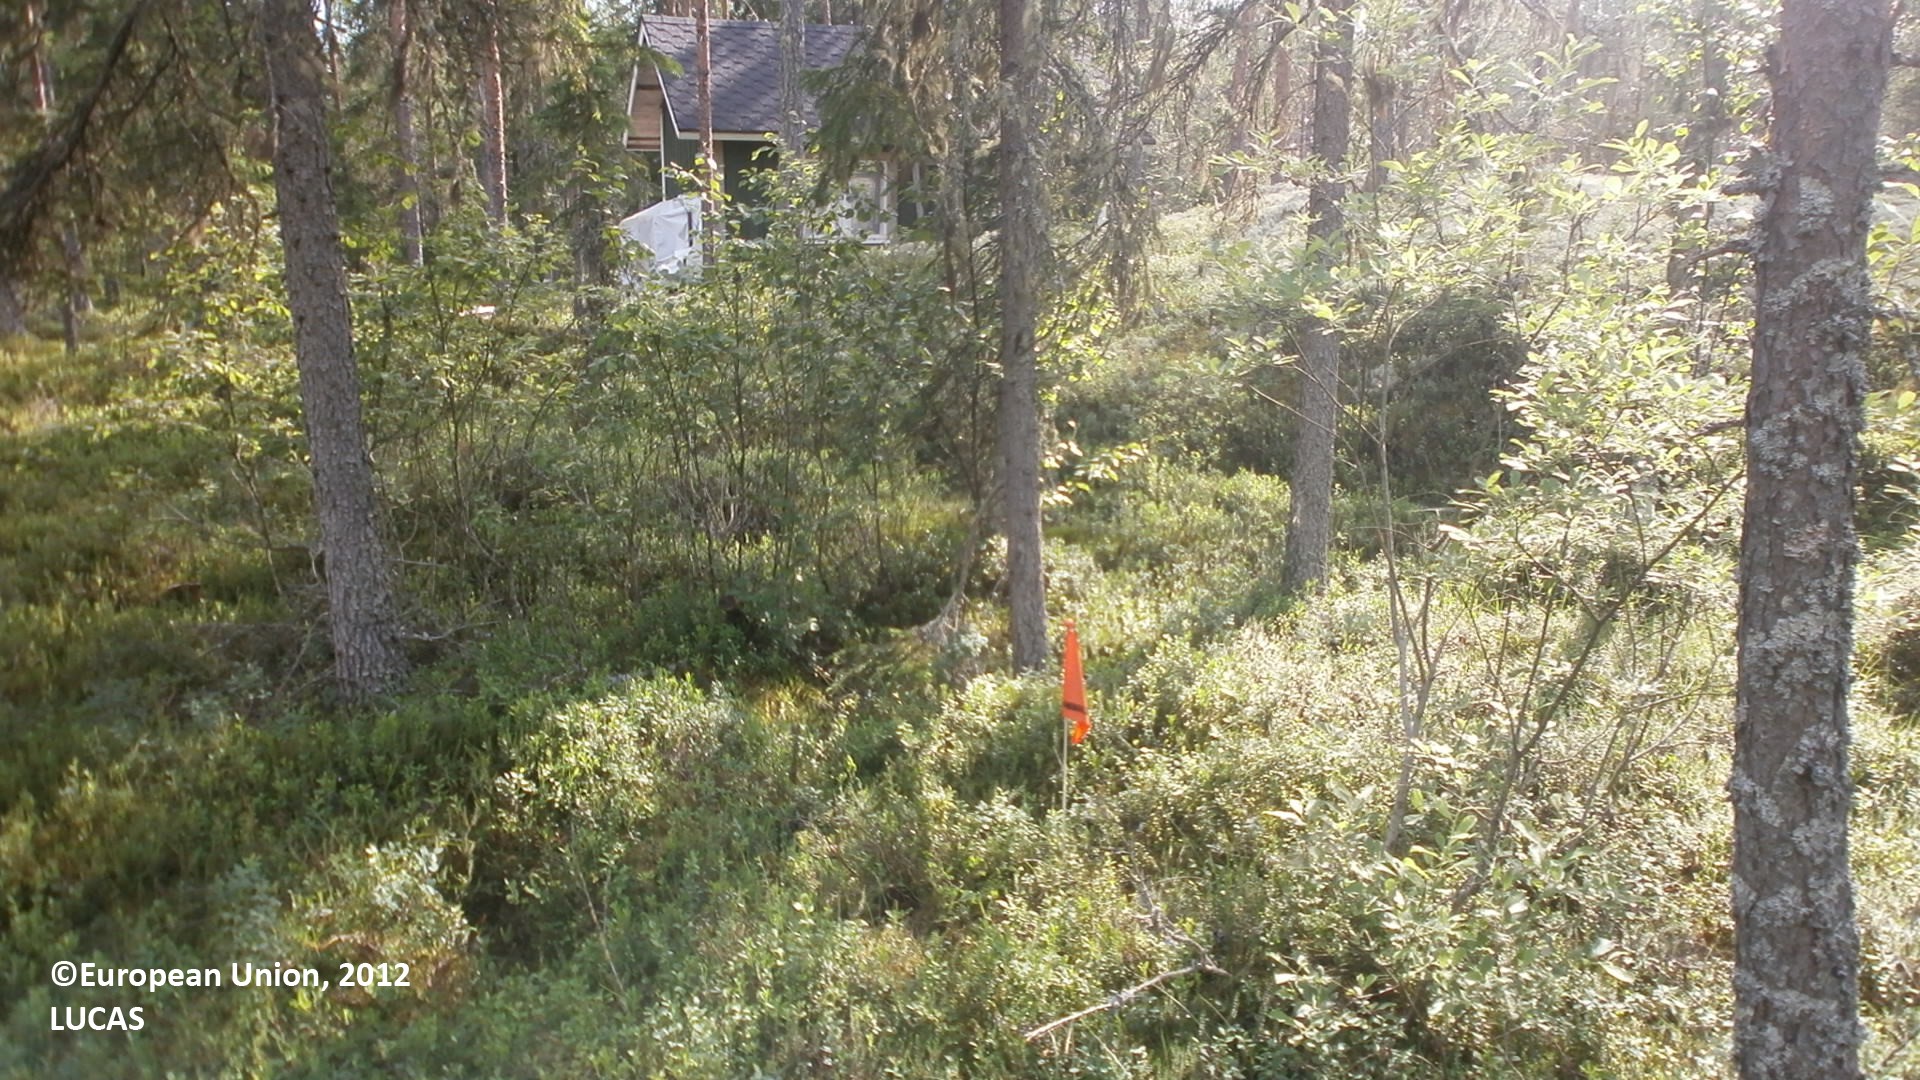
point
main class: Woodland
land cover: Other coniferous woodland
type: boreal forest
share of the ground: 50 - 75 %
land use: Forestry
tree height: > 5 m
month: July
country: FI
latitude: 64.3054
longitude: 24.2263
